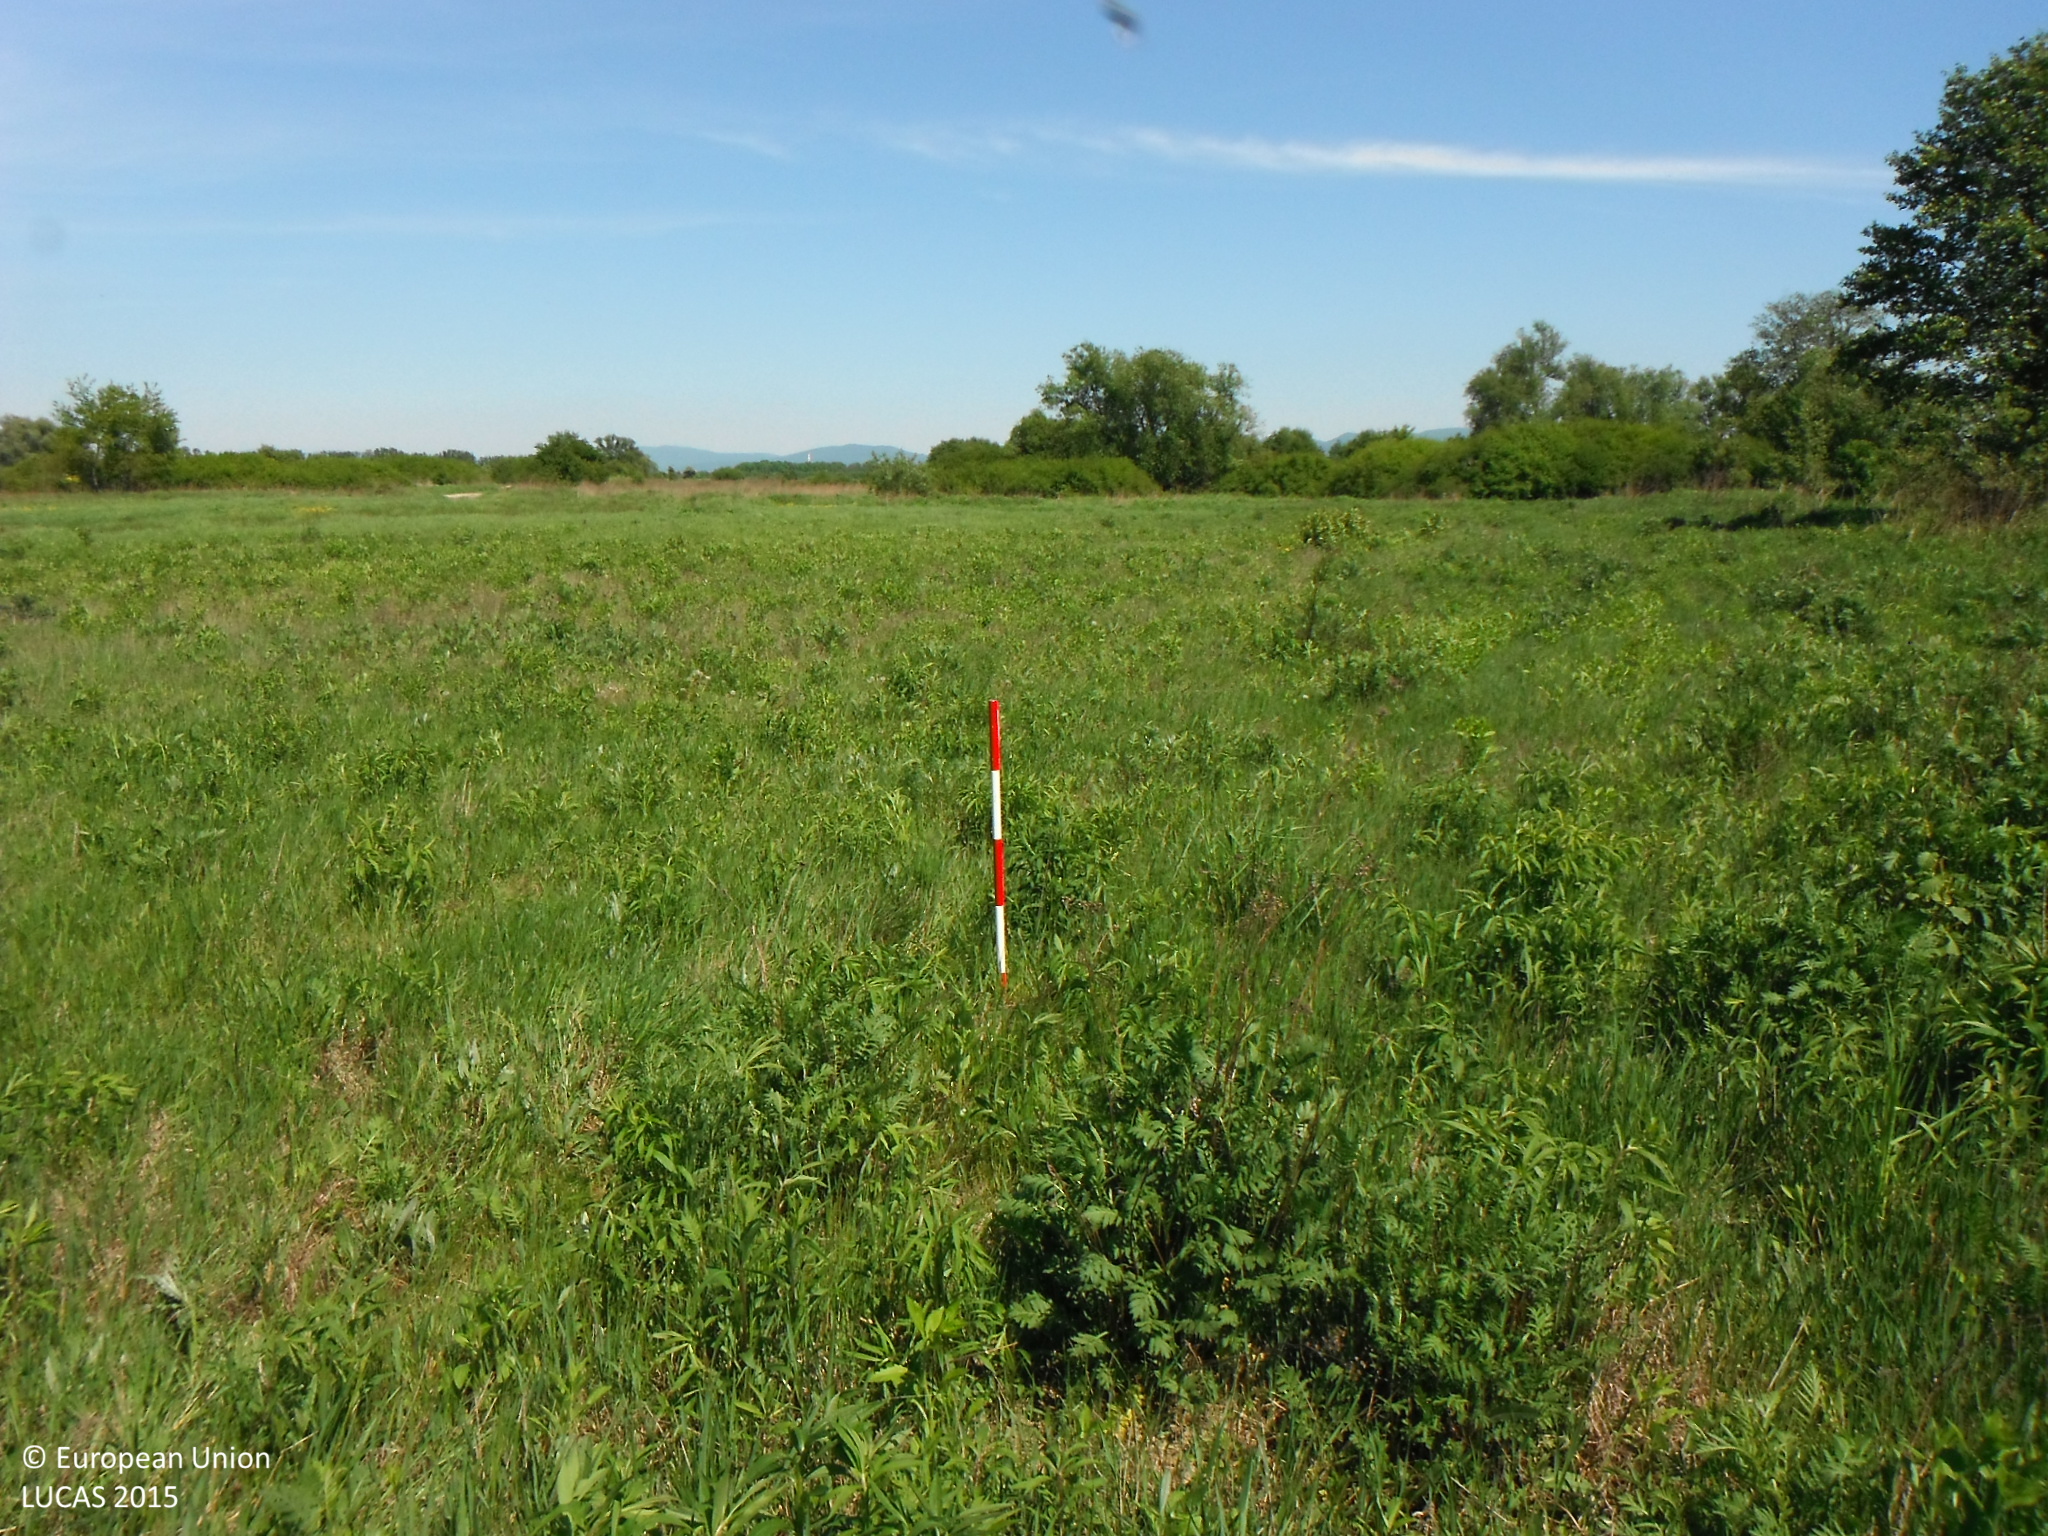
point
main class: Grassland
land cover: Spontaneously vegetated surfaces
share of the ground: > 75 %
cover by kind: herbaceous plants 100 %
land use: Fallow land
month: May
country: SK
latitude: 48.5623
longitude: 21.1677
